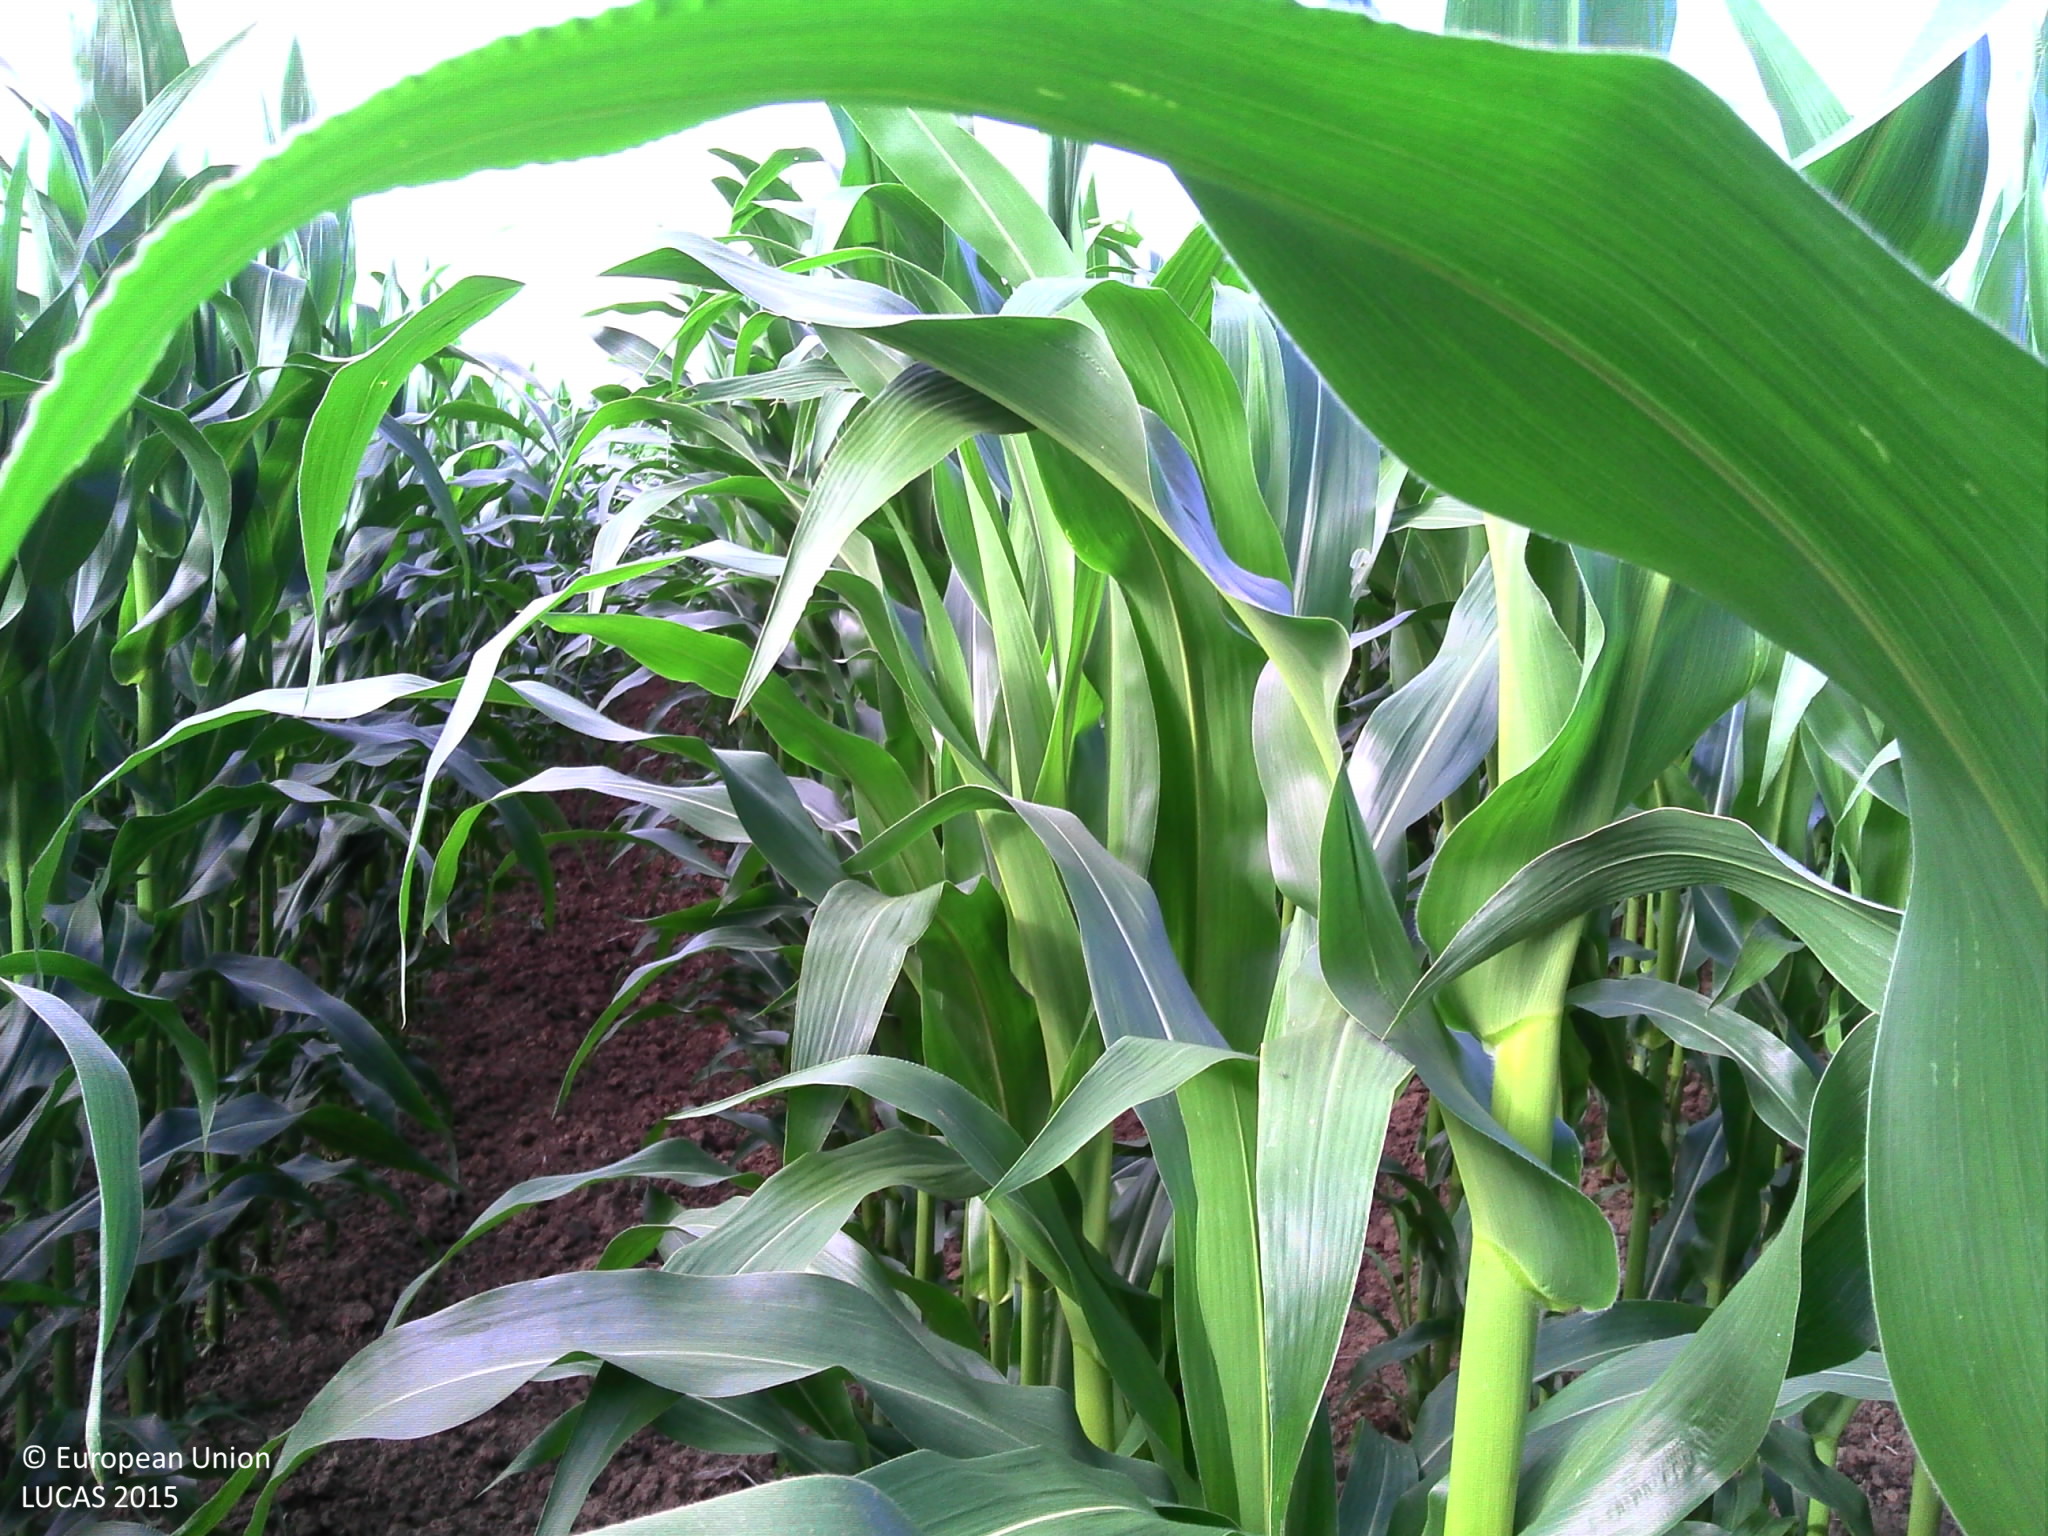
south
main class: Cropland
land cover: Maize
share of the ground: > 75 %
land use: Agriculture (excluding fallow land and kitchen gardens)
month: July
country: BE
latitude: 49.6853
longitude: 5.6048
